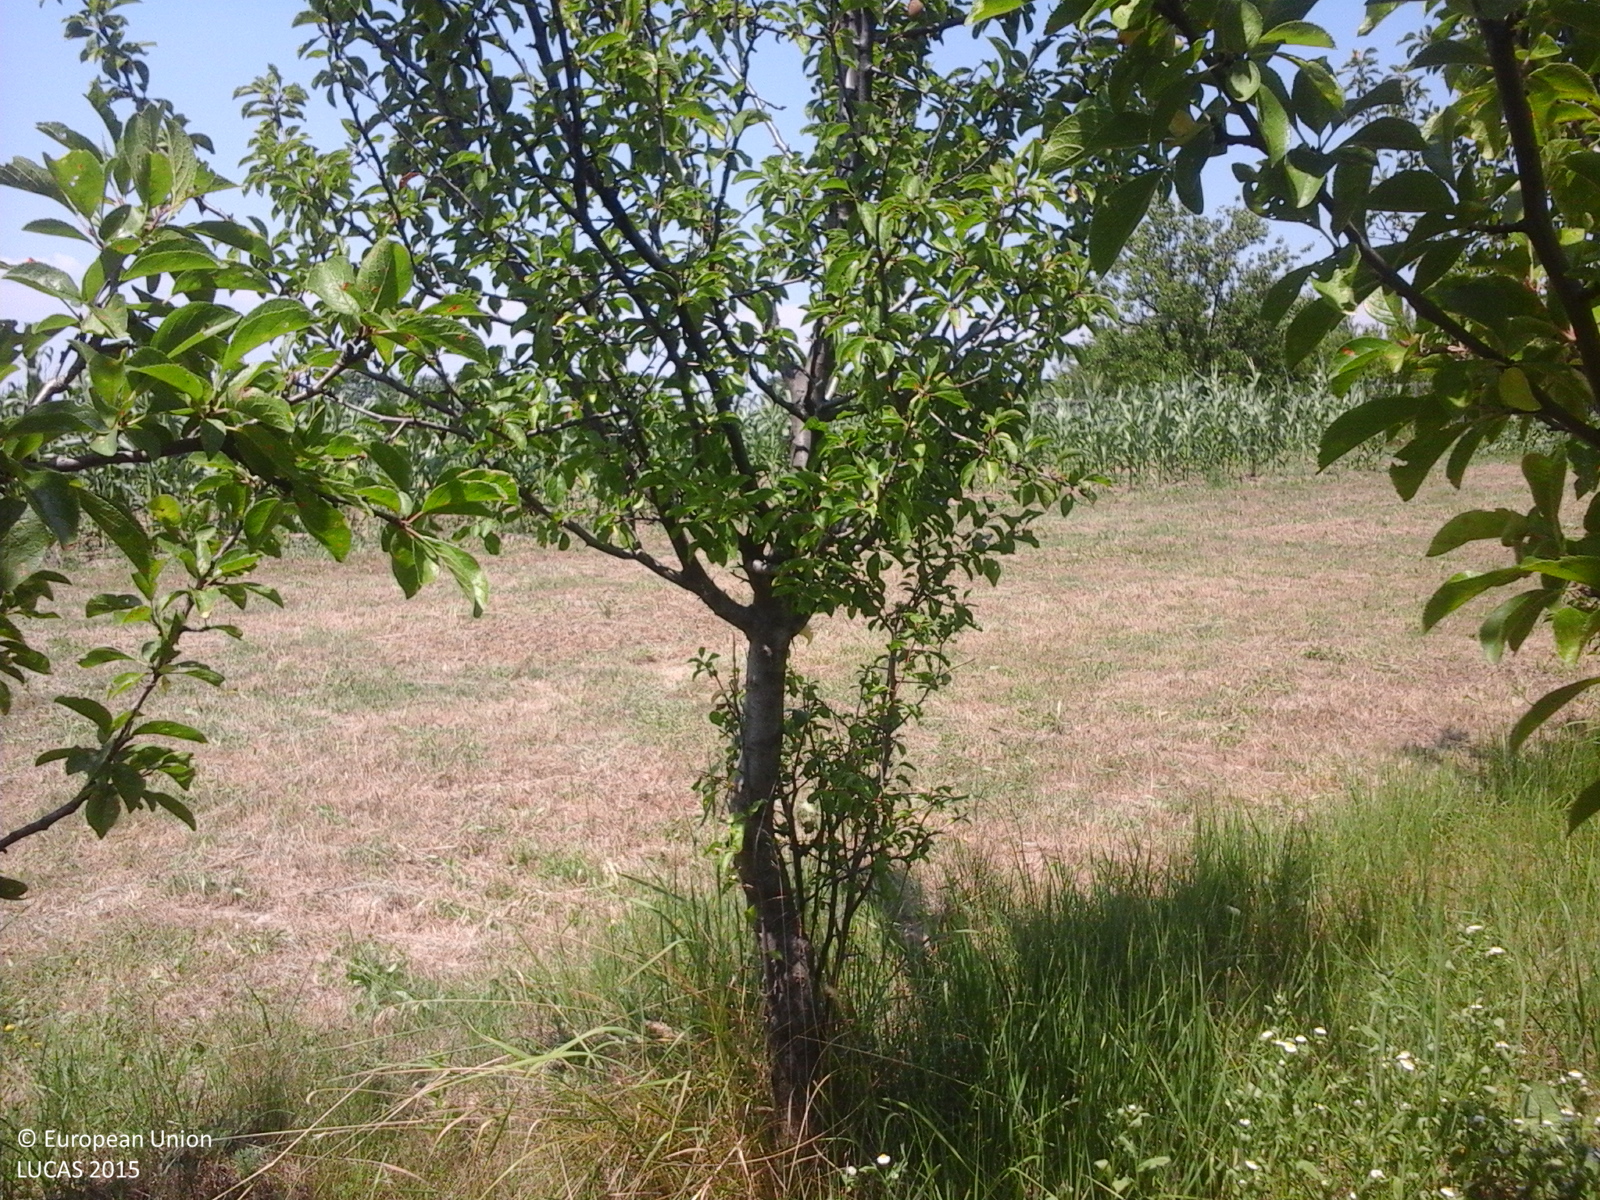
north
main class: Cropland
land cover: Other fruit trees and berries
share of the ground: > 75 %
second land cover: Grassland without tree/shrub cover
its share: > 75 %
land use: Agriculture (excluding fallow land and kitchen gardens)
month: July
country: RO
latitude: 44.8081
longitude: 24.6292
